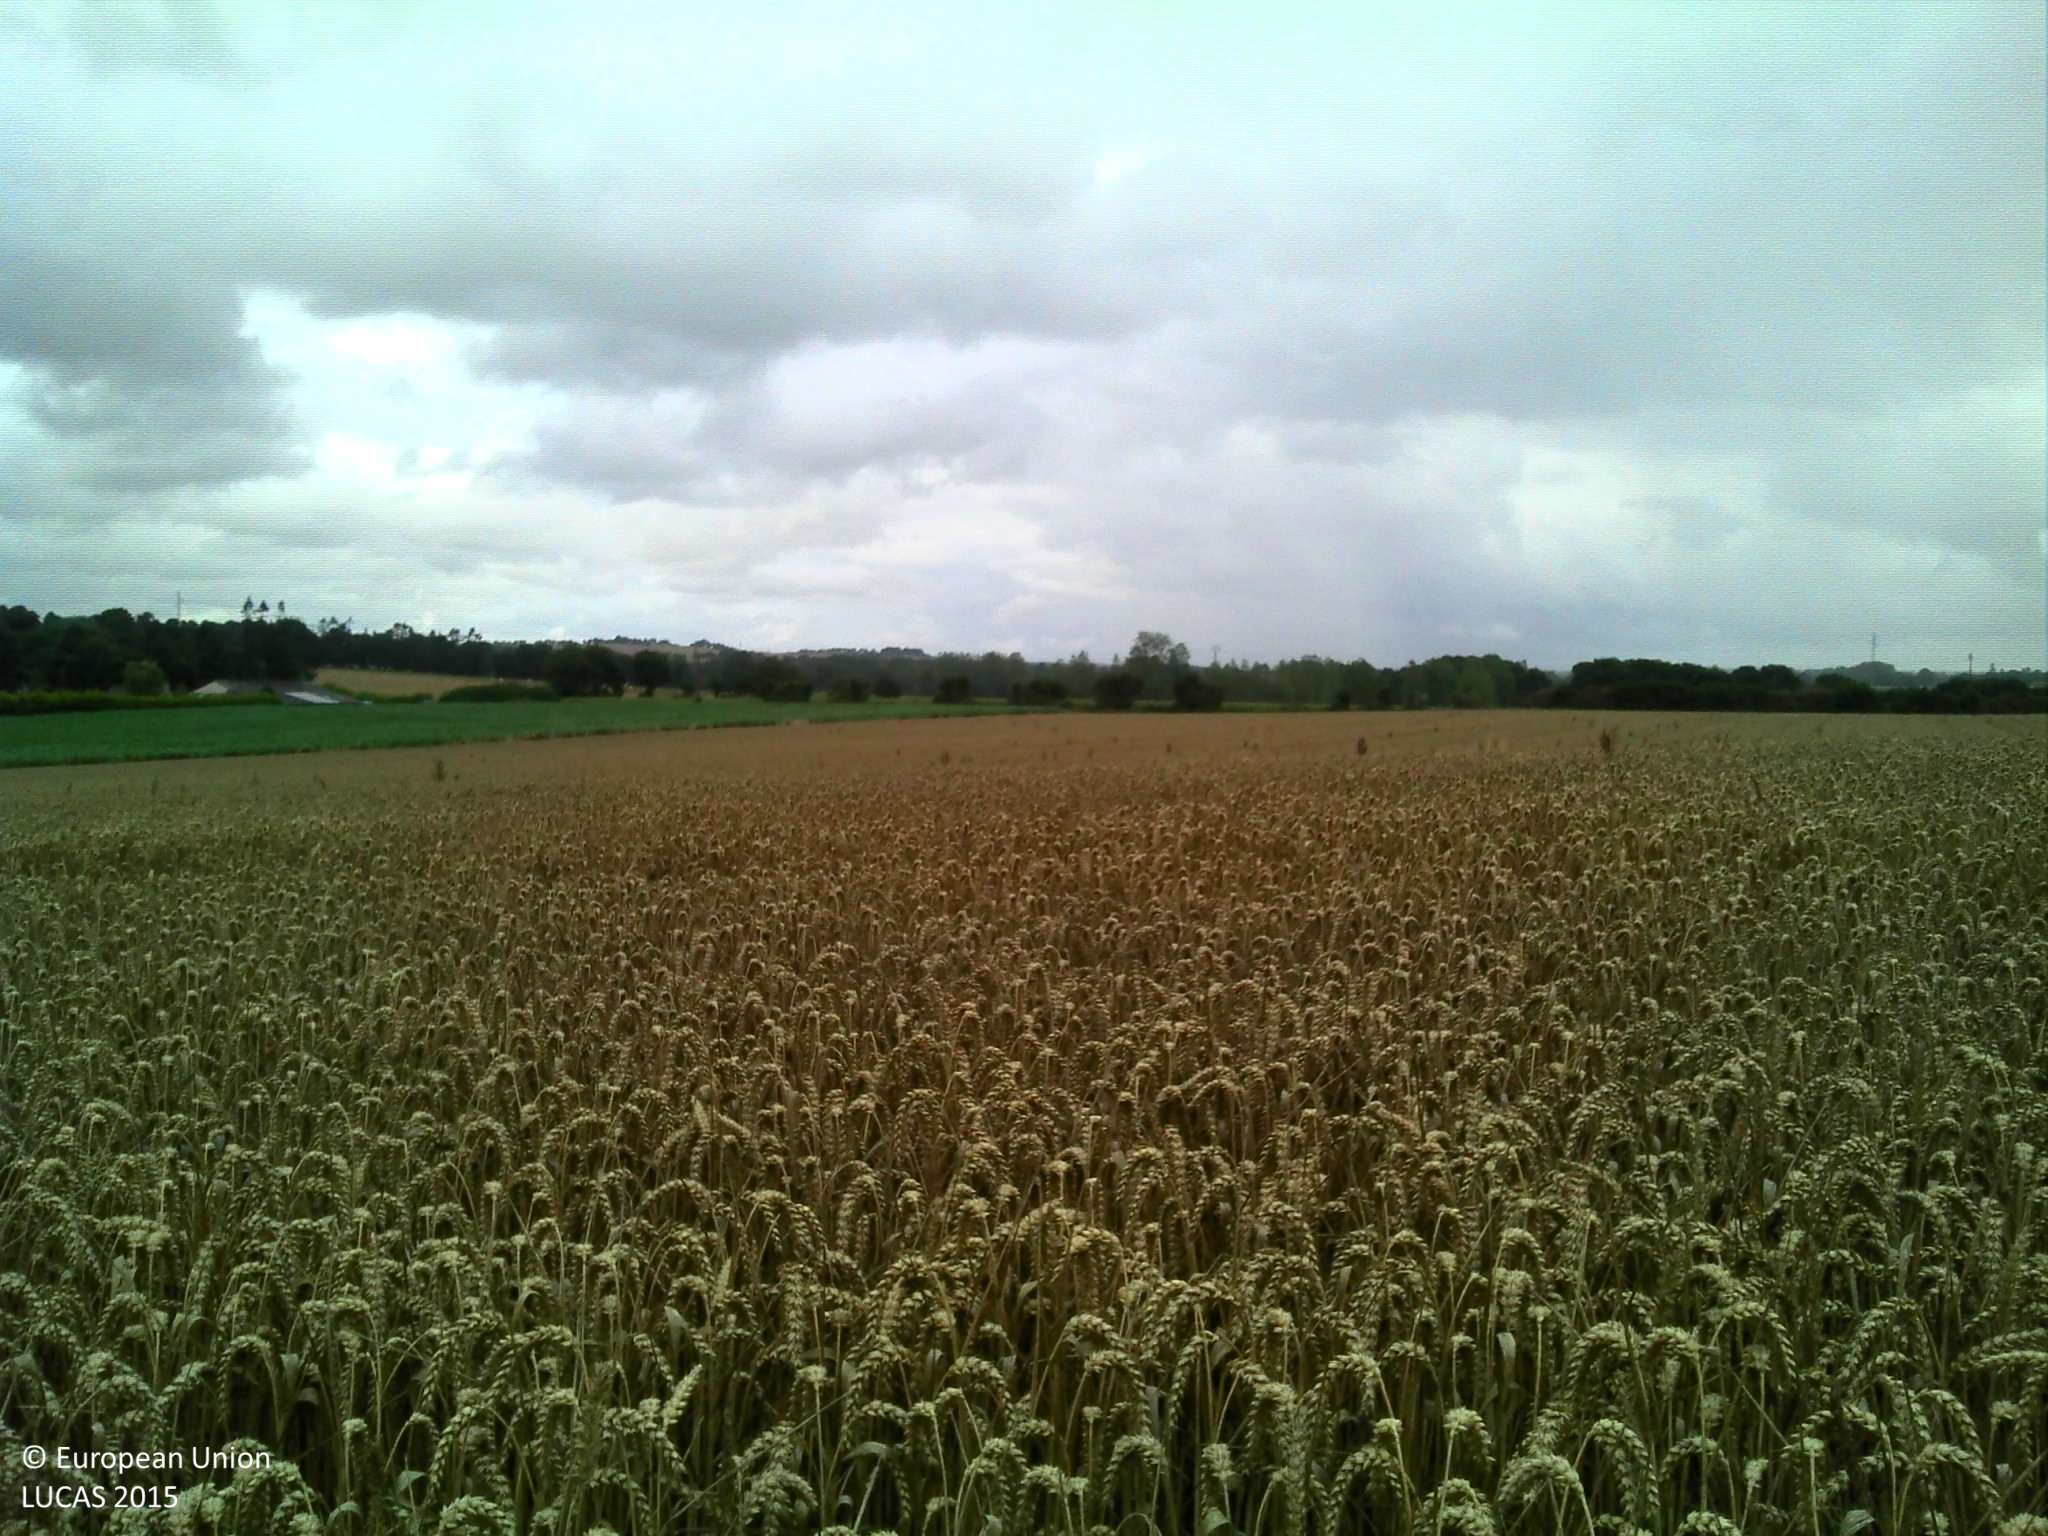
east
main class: Cropland
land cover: Common wheat
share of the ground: > 75 %
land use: Agriculture (excluding fallow land and kitchen gardens)
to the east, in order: Common wheat; Electric lines; Fences; Lines of trees; Ditches and canals; Grass margins; Paved roads, cycling and walking lanes; Grass margins; Maize
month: August
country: FR
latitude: 48.2906
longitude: -3.1319
